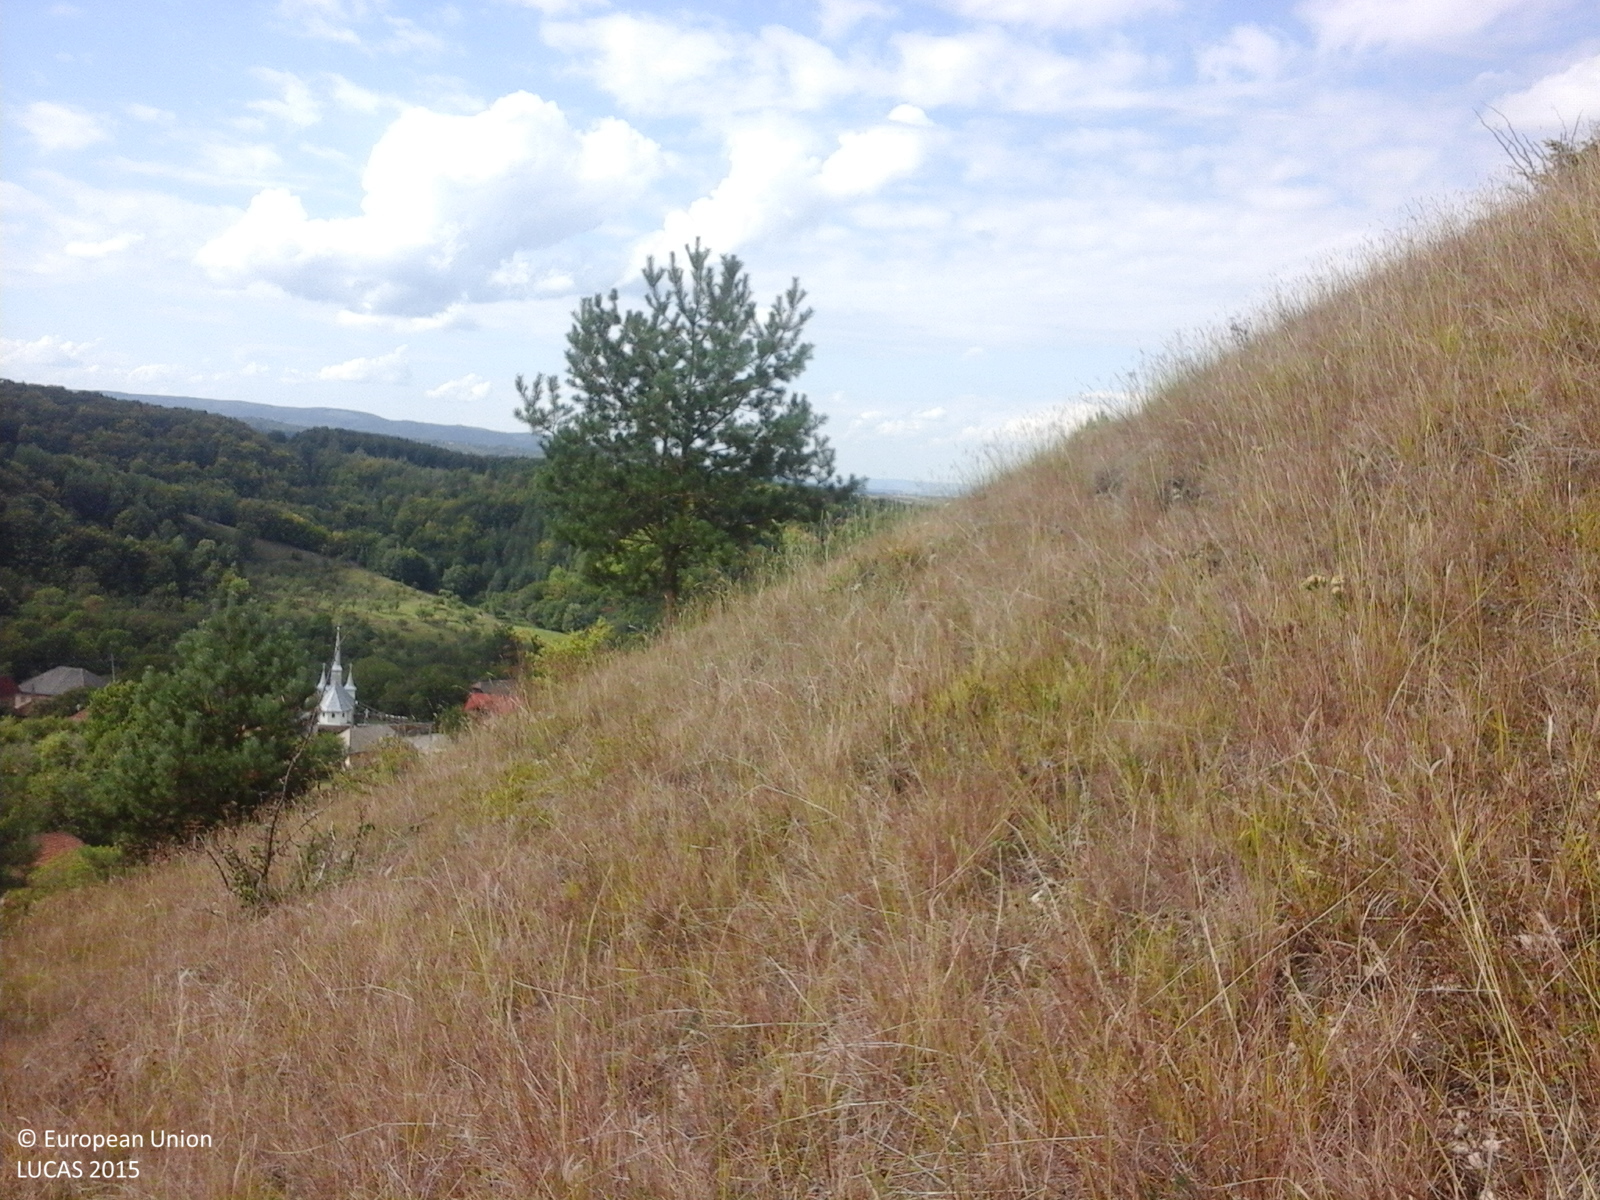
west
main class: Grassland
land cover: Grassland with sparse tree/shrub cover
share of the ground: > 75 %
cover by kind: herbaceous plants 85 %, shrubs 10 %, broadleaved forest trees 5 %
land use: Agriculture (excluding fallow land and kitchen gardens)
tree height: < 5 m
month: September
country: RO
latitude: 47.4600
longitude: 23.5114
